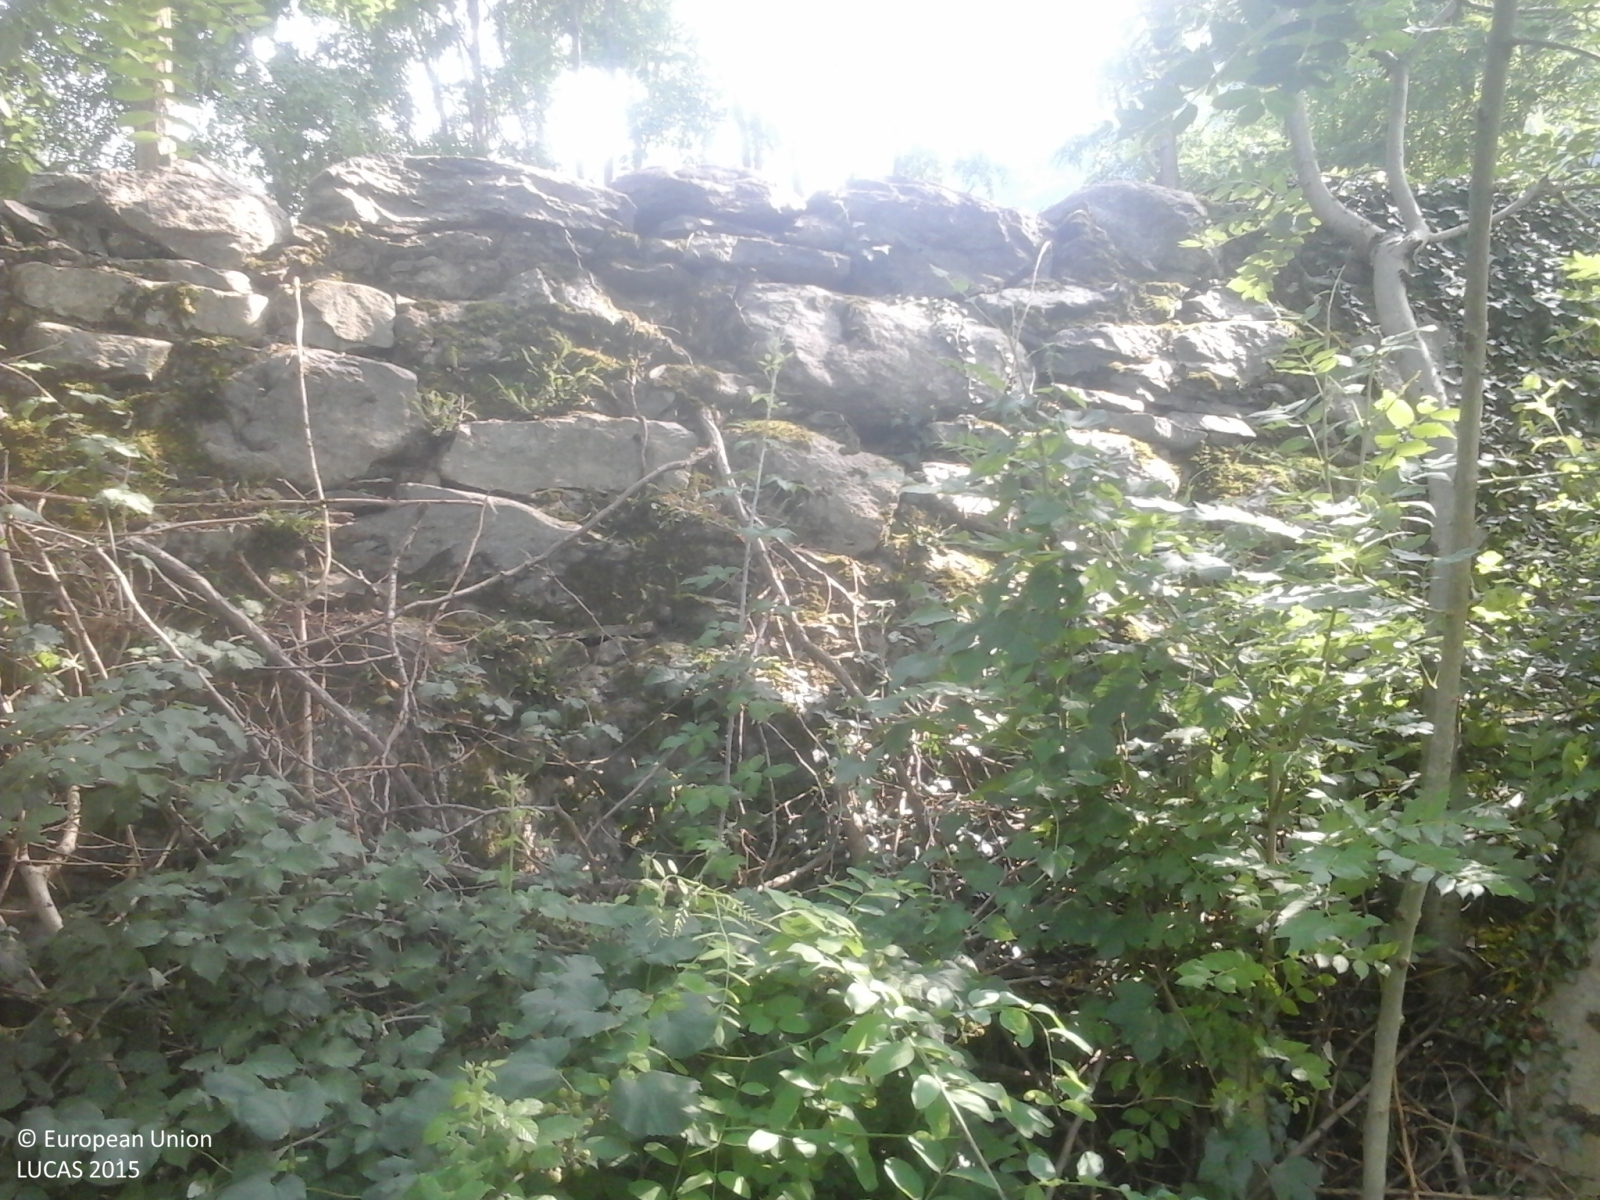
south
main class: Woodland
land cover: Broadleaved woodland
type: thermophilous deciduous forest
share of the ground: > 75 %
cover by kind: broadleaved forest trees 100 %
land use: Forestry
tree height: > 5 m
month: July
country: IT
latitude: 46.2953
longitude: 9.3648
